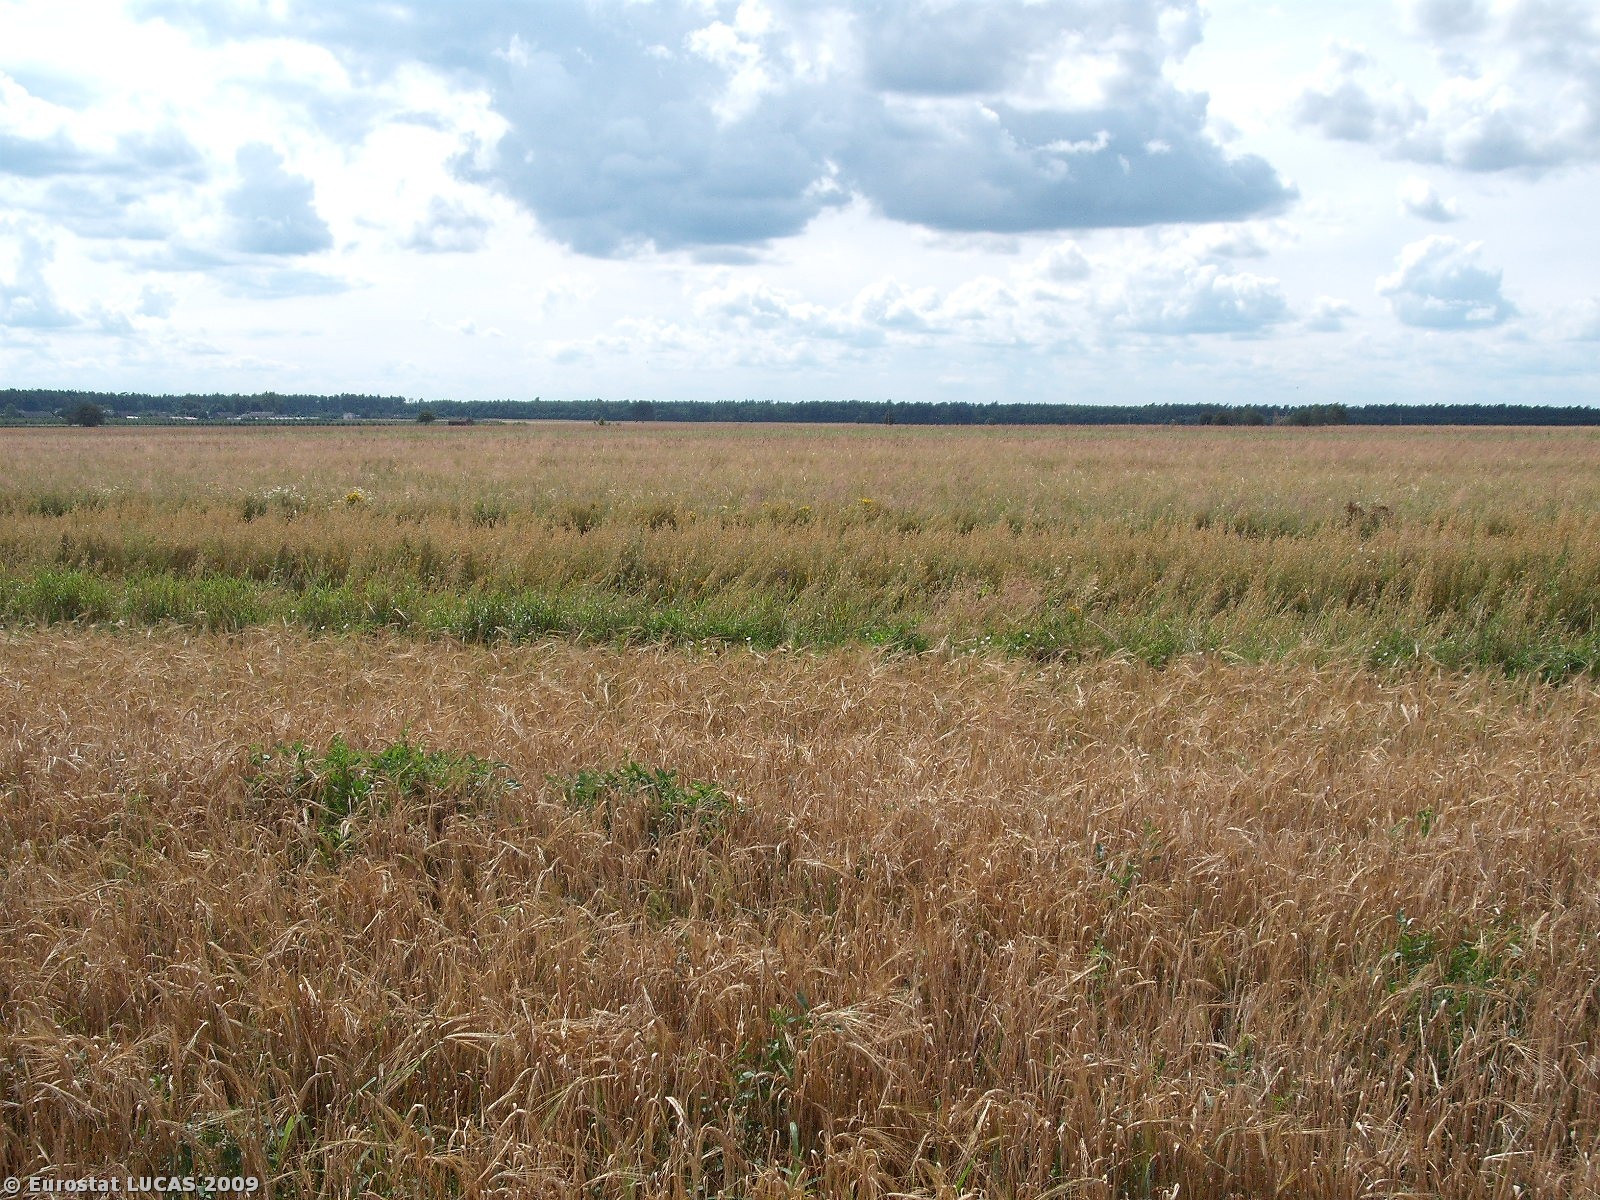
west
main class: Cropland
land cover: Oats
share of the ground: > 75 %
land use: Agriculture (excluding fallow land and kitchen gardens)
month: July
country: PL
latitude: 51.1050
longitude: 21.3461
